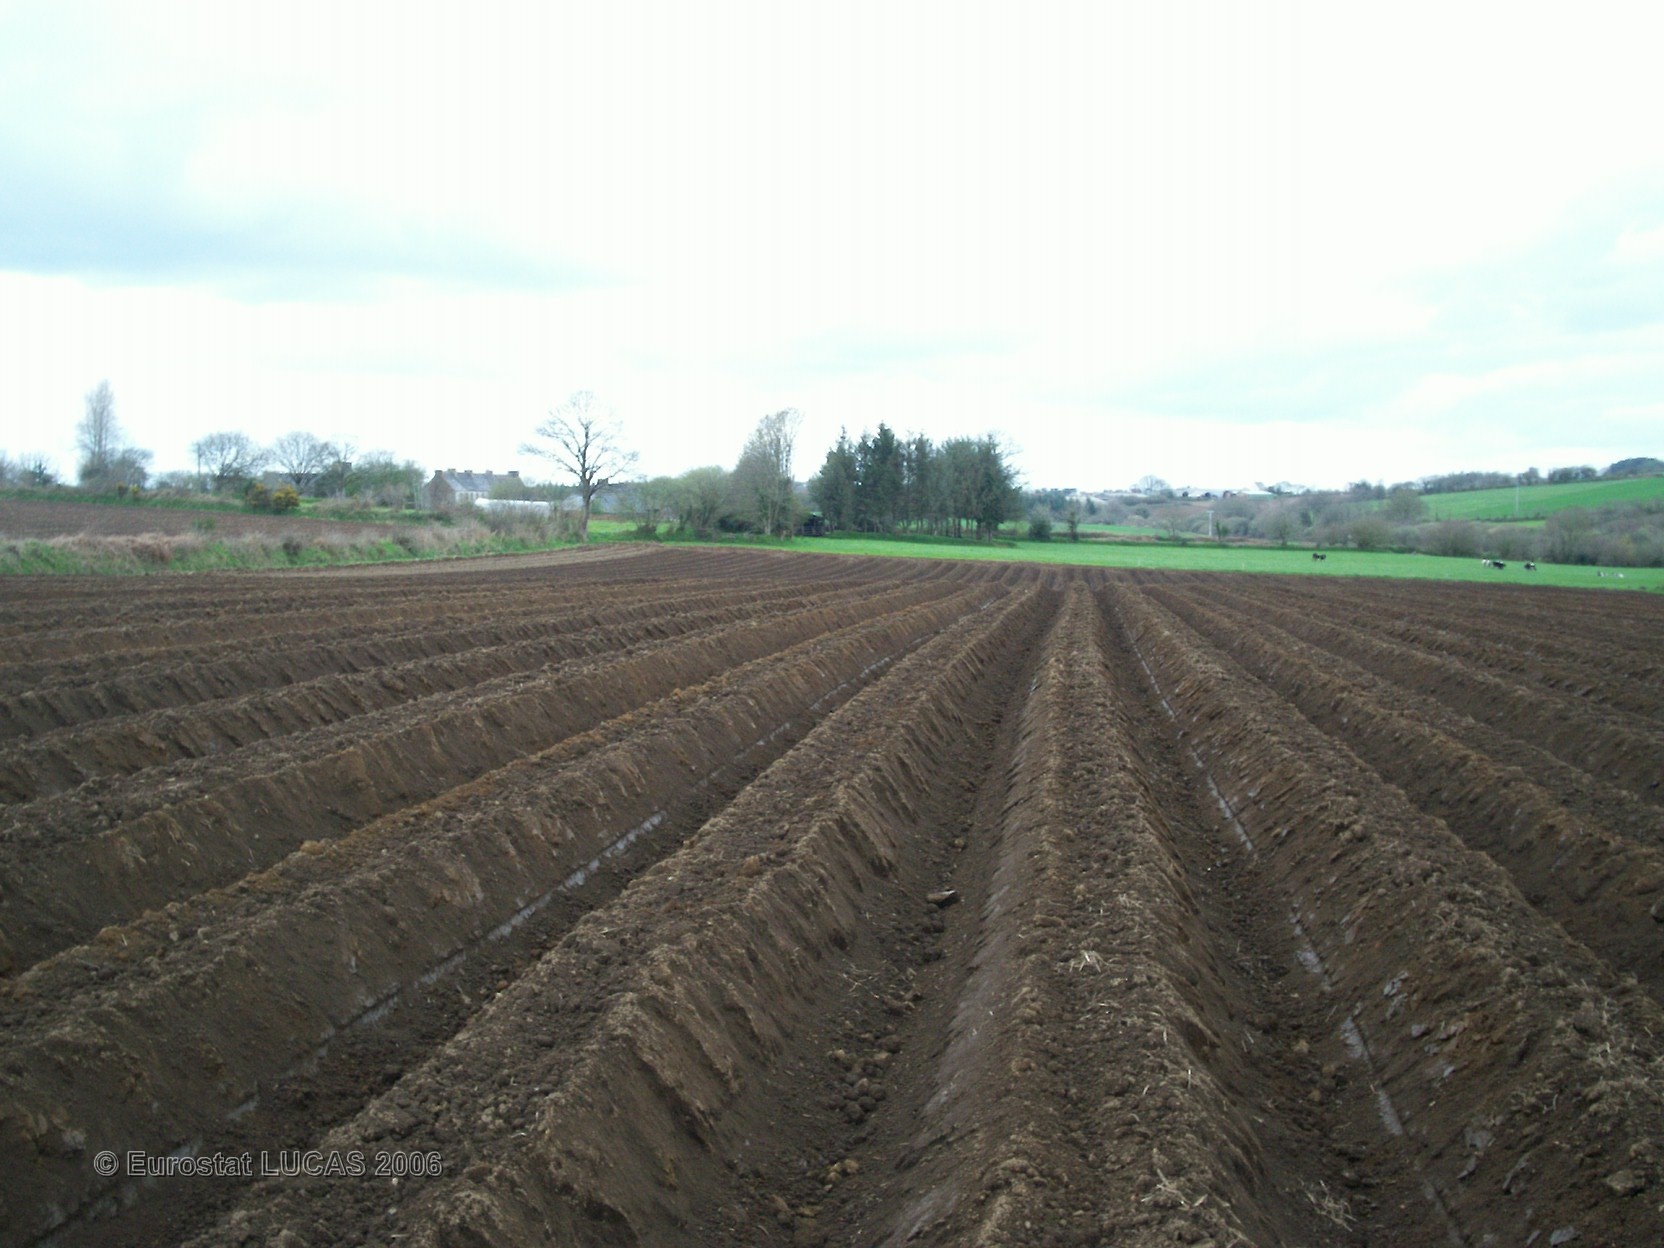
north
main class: Cropland
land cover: Potatoes
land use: Agriculture (excluding fallow land and kitchen gardens)
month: June
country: FR
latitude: 48.4211
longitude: -3.9928
